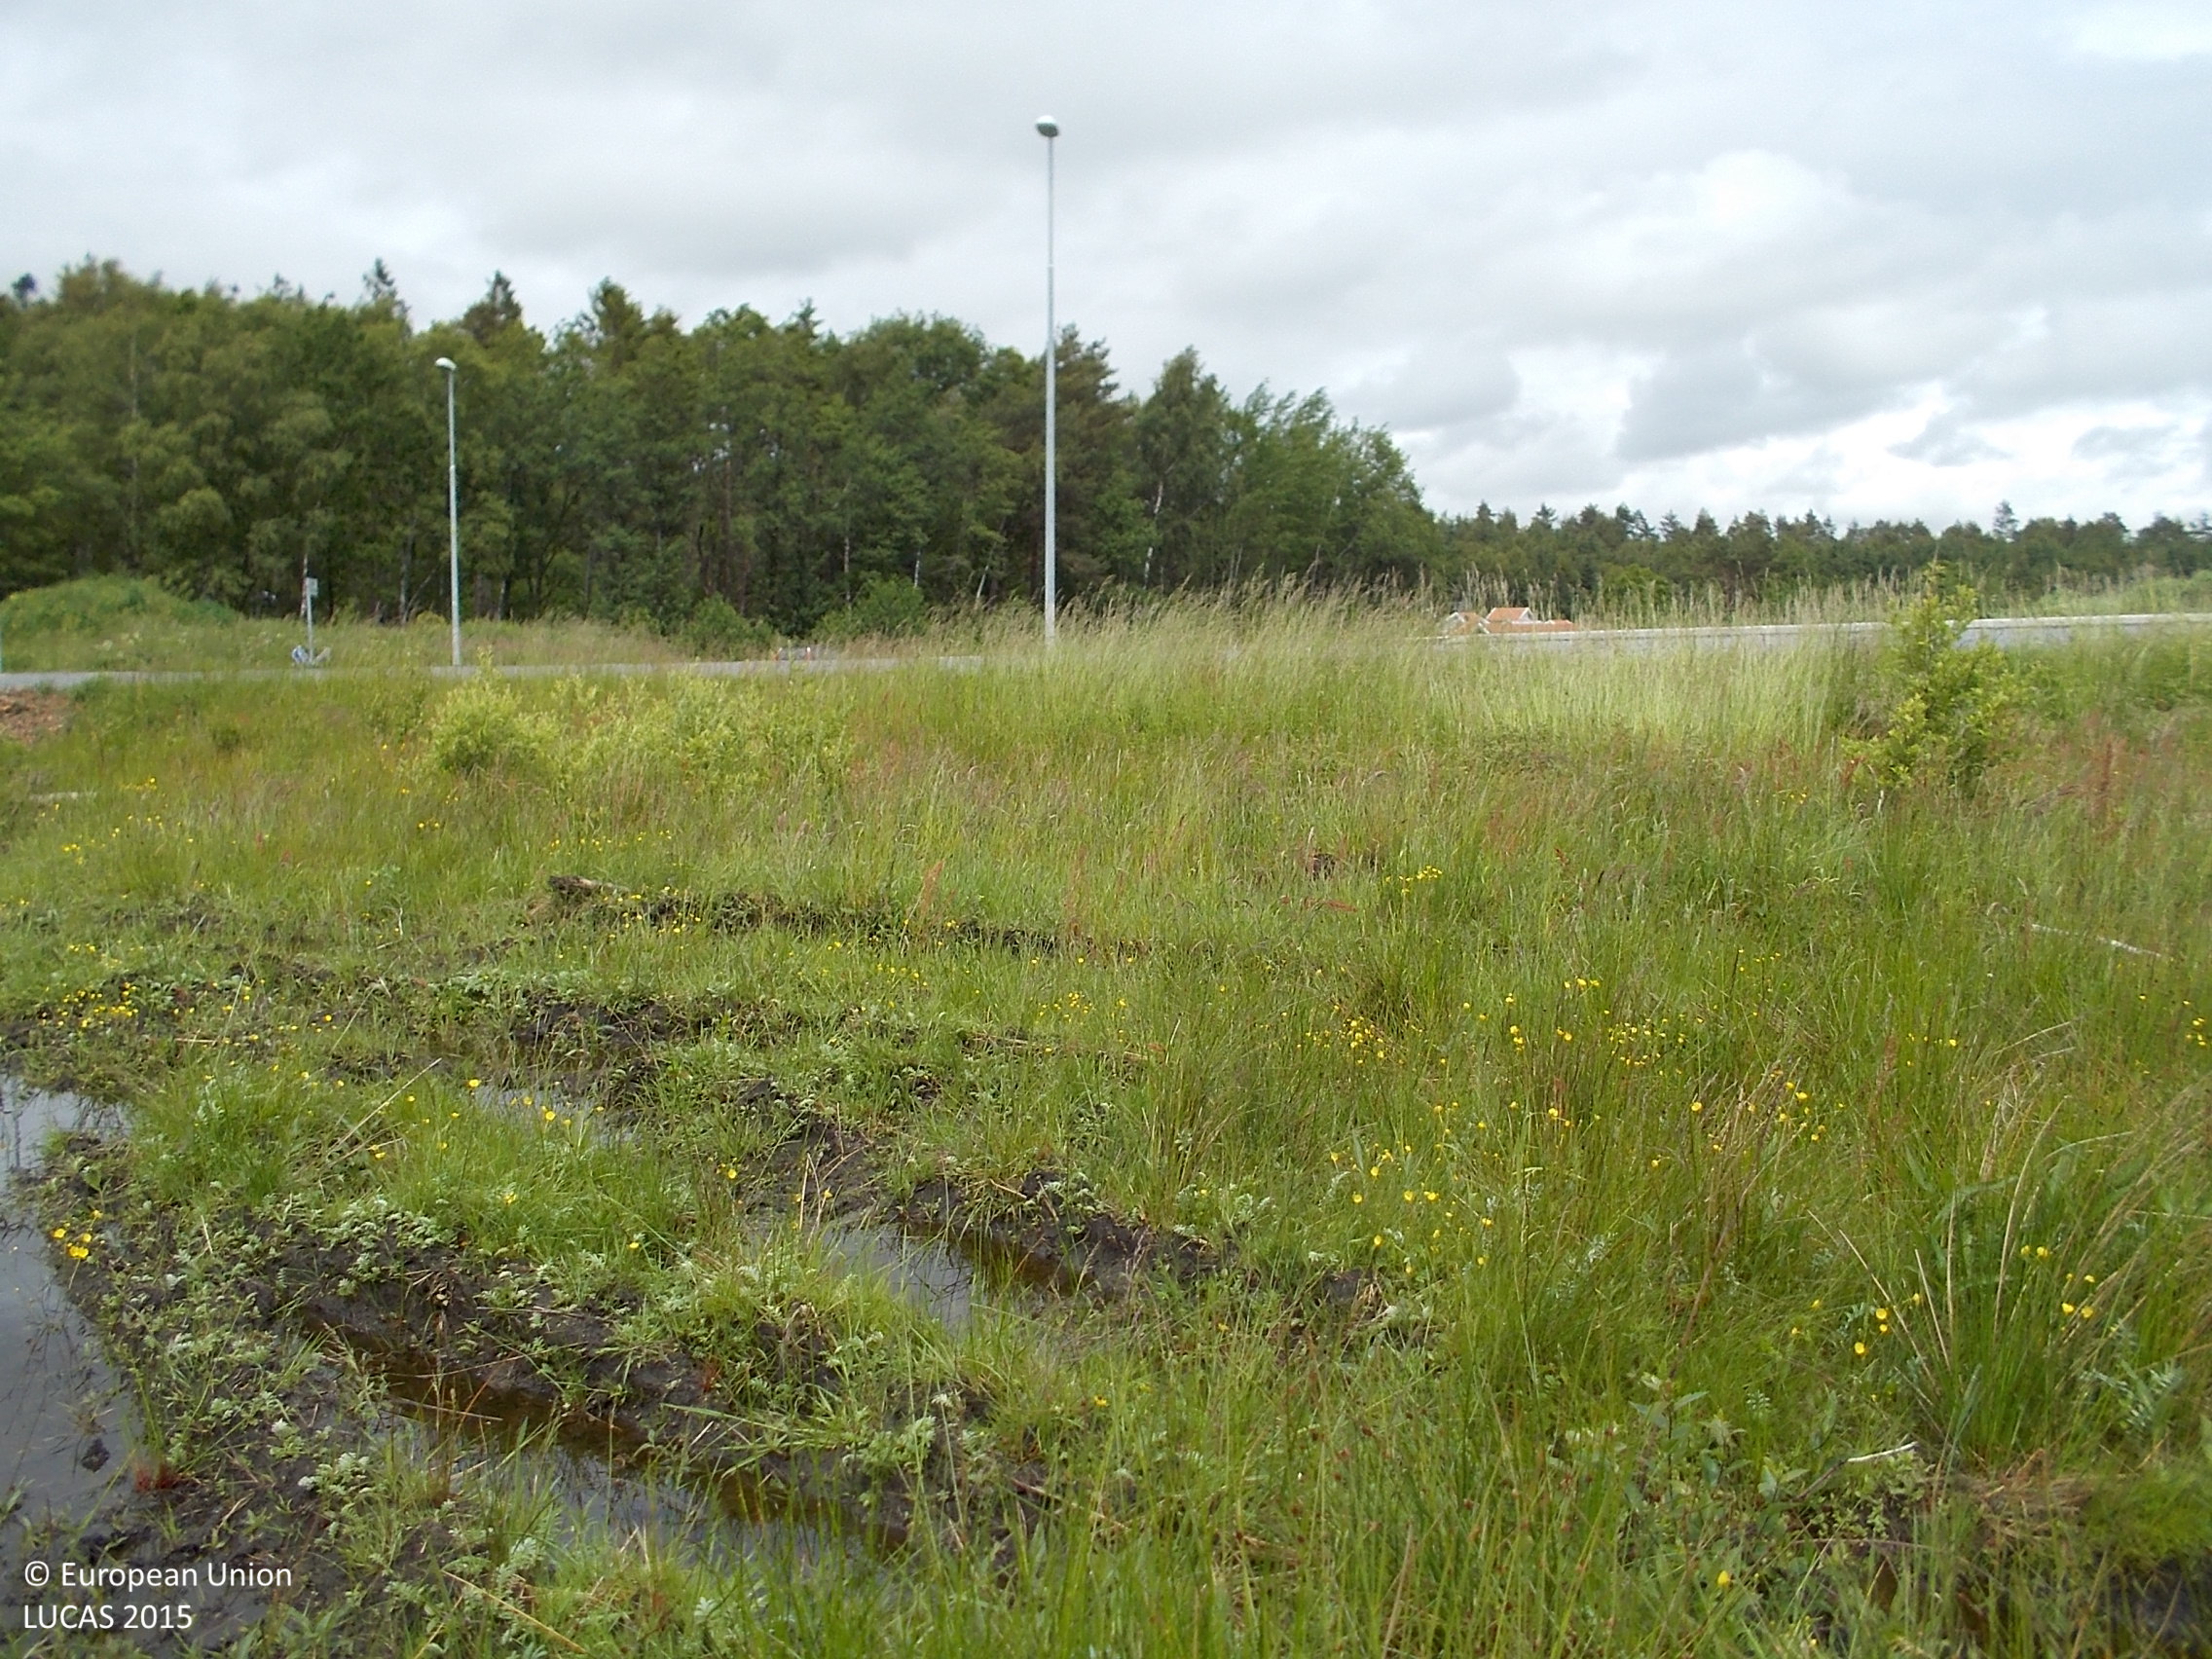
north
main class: Grassland
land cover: Spontaneously vegetated surfaces
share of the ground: > 75 %
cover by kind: herbaceous plants 95 %, shrubs 5 %
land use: Fallow land
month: June
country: SE
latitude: 57.4499
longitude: 11.9467
